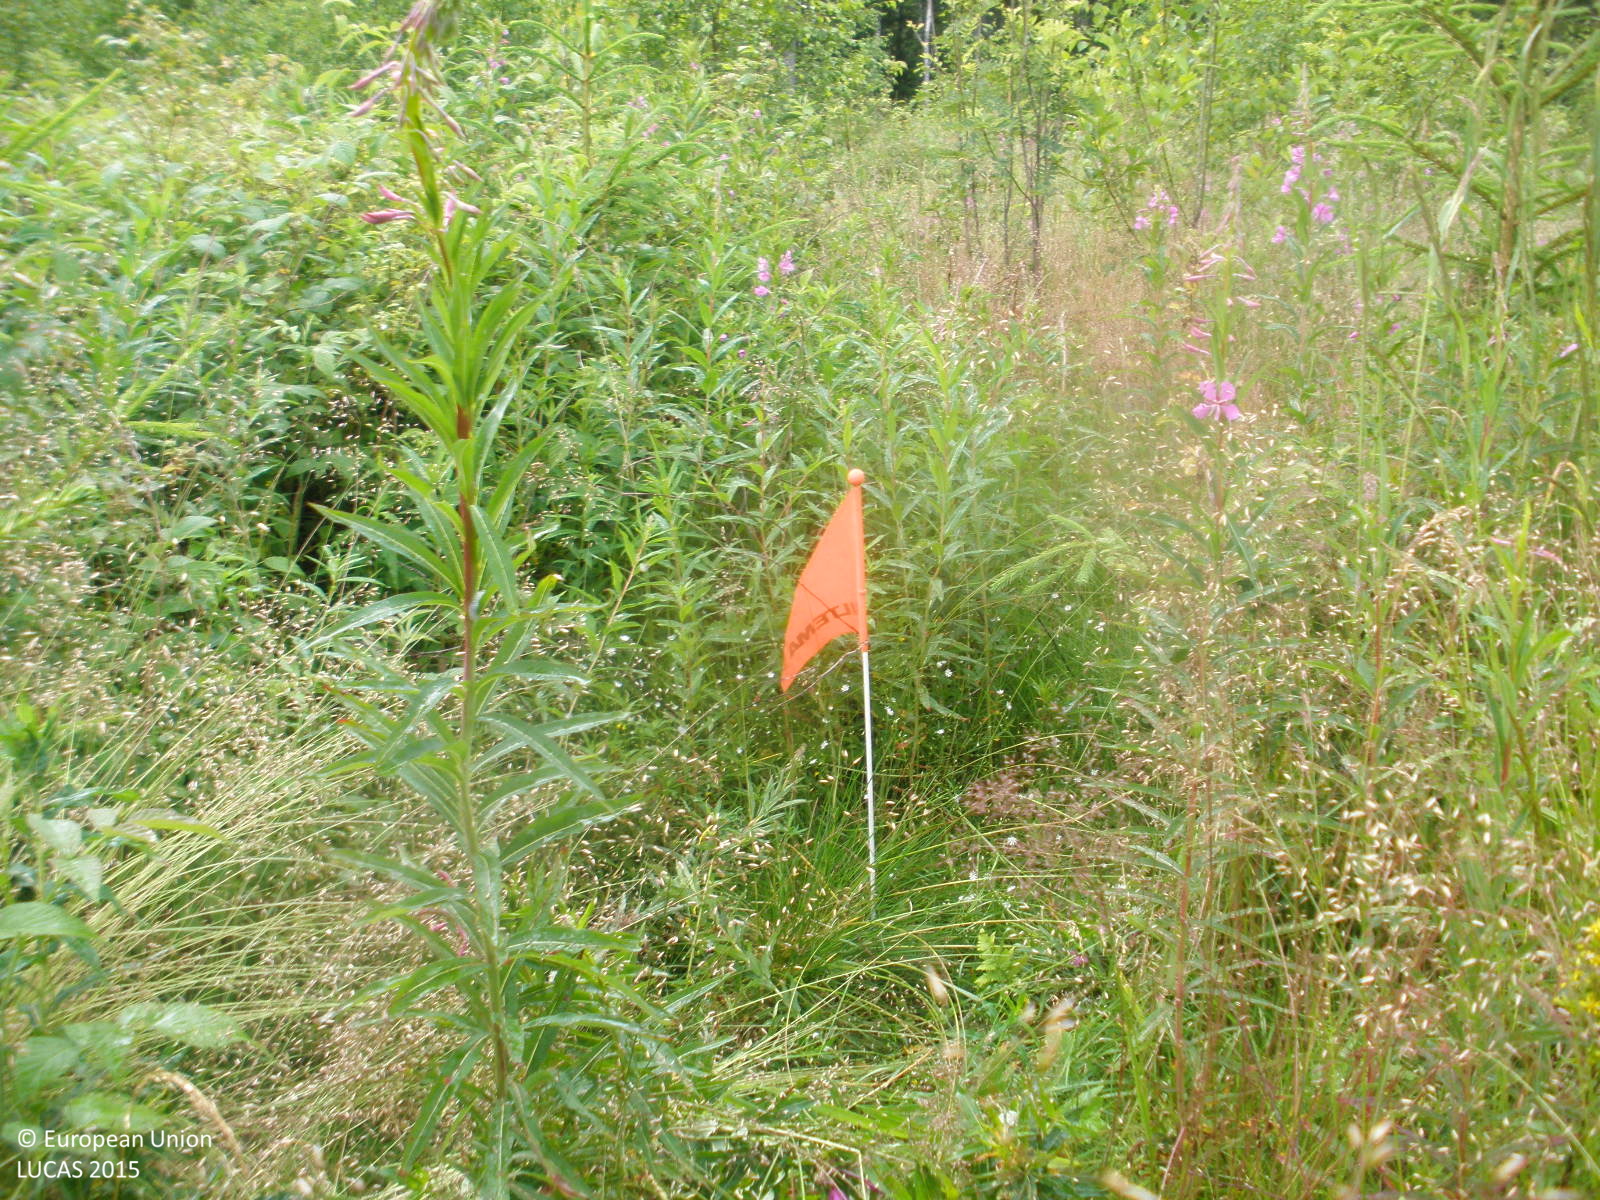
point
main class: Woodland
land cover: Other mixed woodland
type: boreal forest
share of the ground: 50 - 75 %
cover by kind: broadleaved forest trees 40 %, shrubs 35 %, coniferous forest trees 15 %, herbaceous plants 10 %
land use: Forestry
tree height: < 5 m
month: July
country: FI
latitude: 61.4213
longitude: 24.7398
